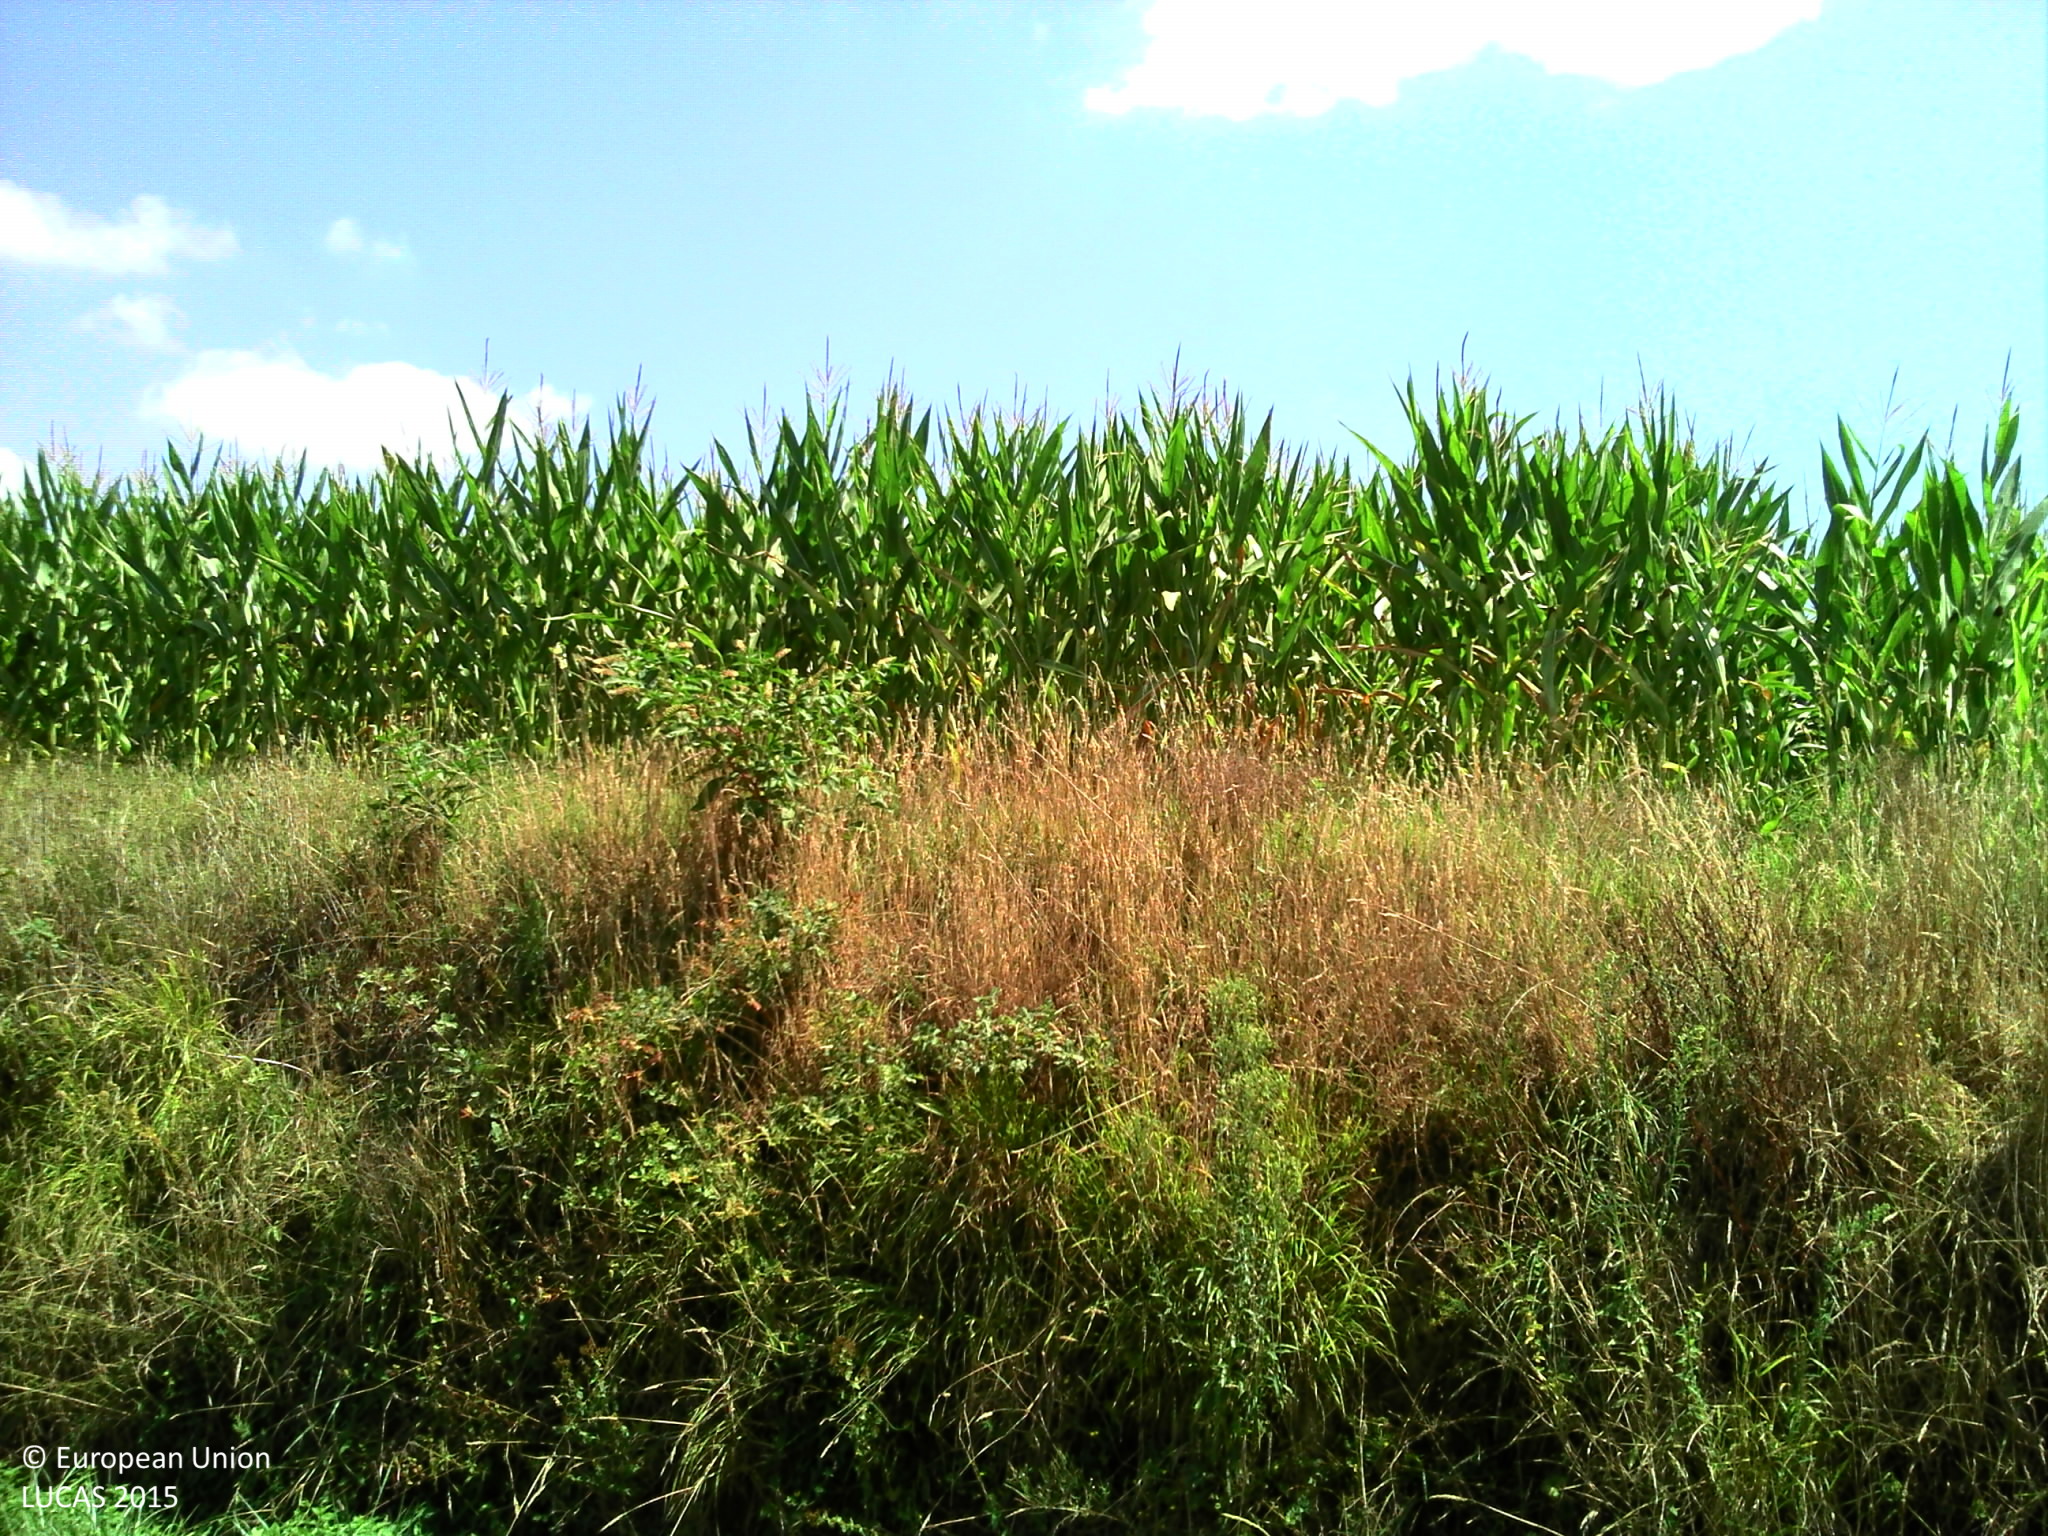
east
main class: Grassland
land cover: Grassland with sparse tree/shrub cover
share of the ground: > 75 %
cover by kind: herbaceous plants 90 %, broadleaved forest trees 5 %, unconsolidated bare surface 5 %
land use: Residential
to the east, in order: Grass margins; Ditches and canals; Paved roads, cycling and walking lanes; Grass margins; Maize; Tracks; Maize; Electric lines; Grass margins; Ditches and canals; Paved roads, cycling and walking lanes; Grass margins; Single bushes/trees; Fences; Grass margins; Rivers and streams; Lines of trees; Grassland without tree/shrub cover; Tracks; Lines of trees; Grassland without tree/shrub cover; Lines of trees
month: August
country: FR
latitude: 43.7026
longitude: -0.5463
